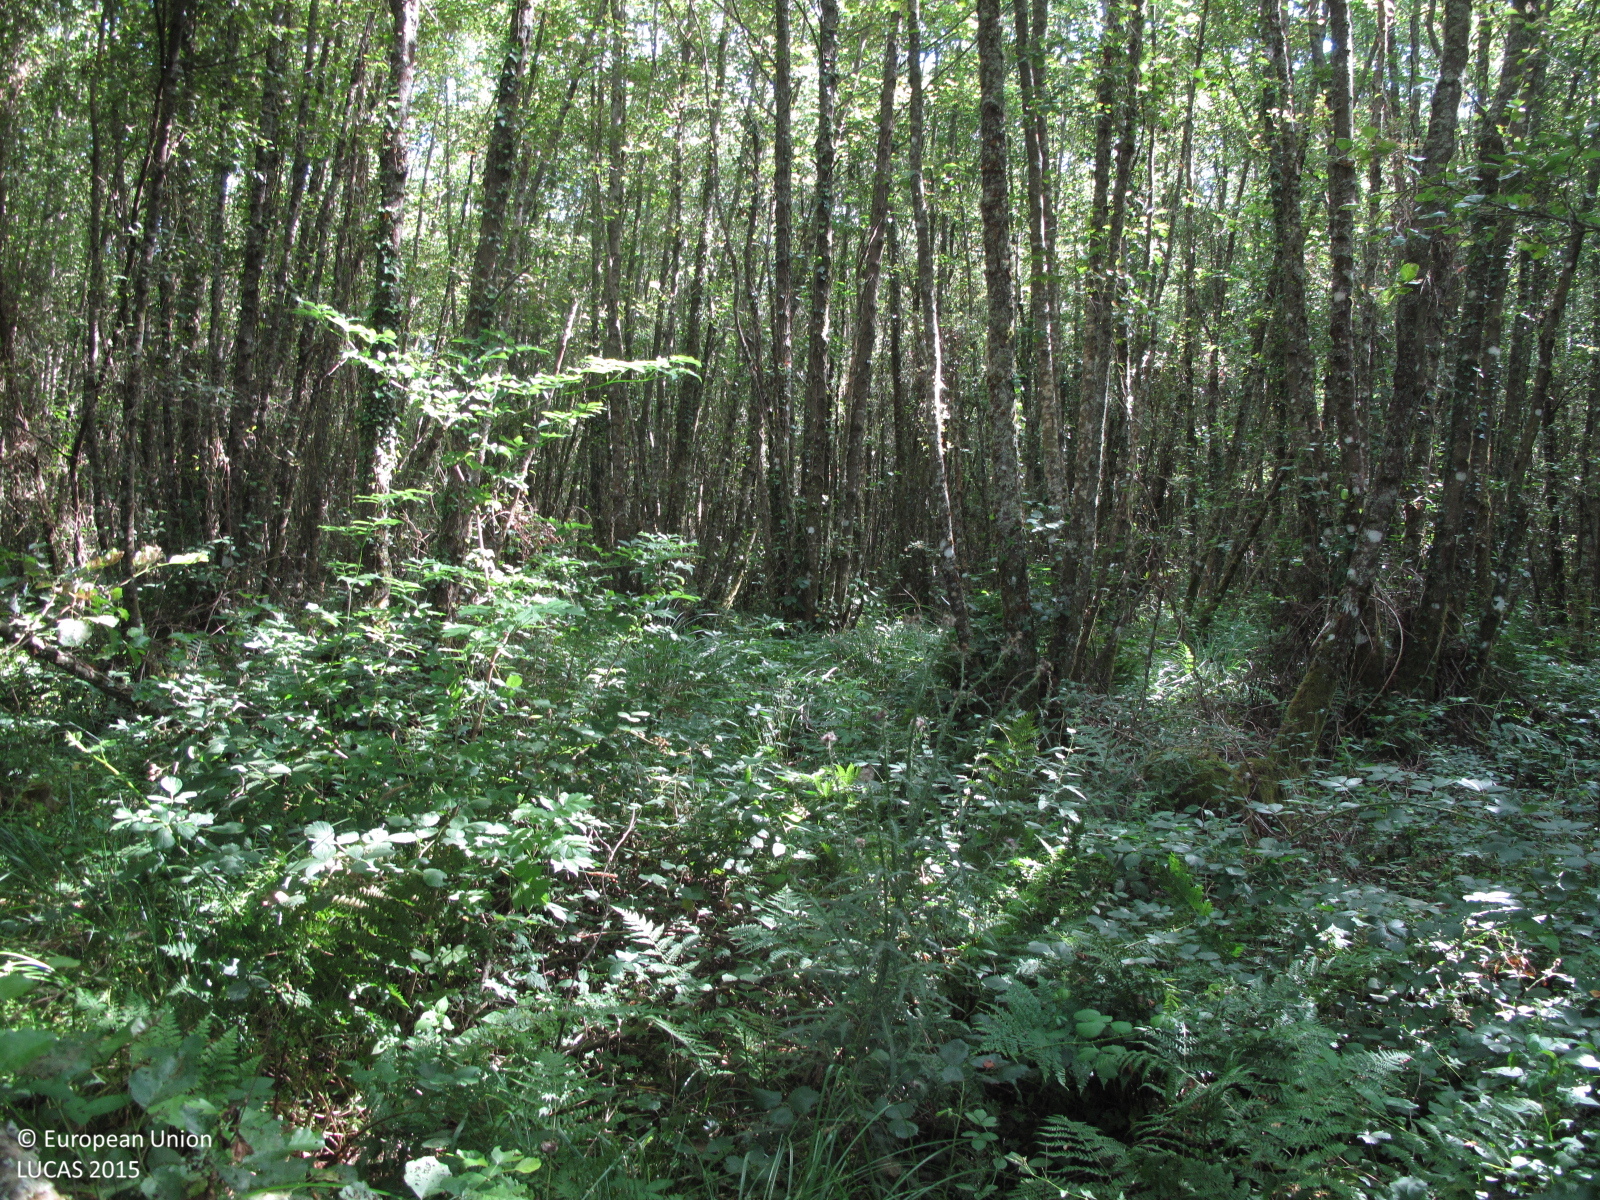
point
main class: Woodland
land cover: Broadleaved woodland
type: floodplain forest
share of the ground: > 75 %
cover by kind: broadleaved forest trees 90 %, shrubs 5 %, herbaceous plants 5 %
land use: Semi-natural and natural areas not in use
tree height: > 5 m
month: July
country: ES
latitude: 43.0592
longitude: -7.9798
